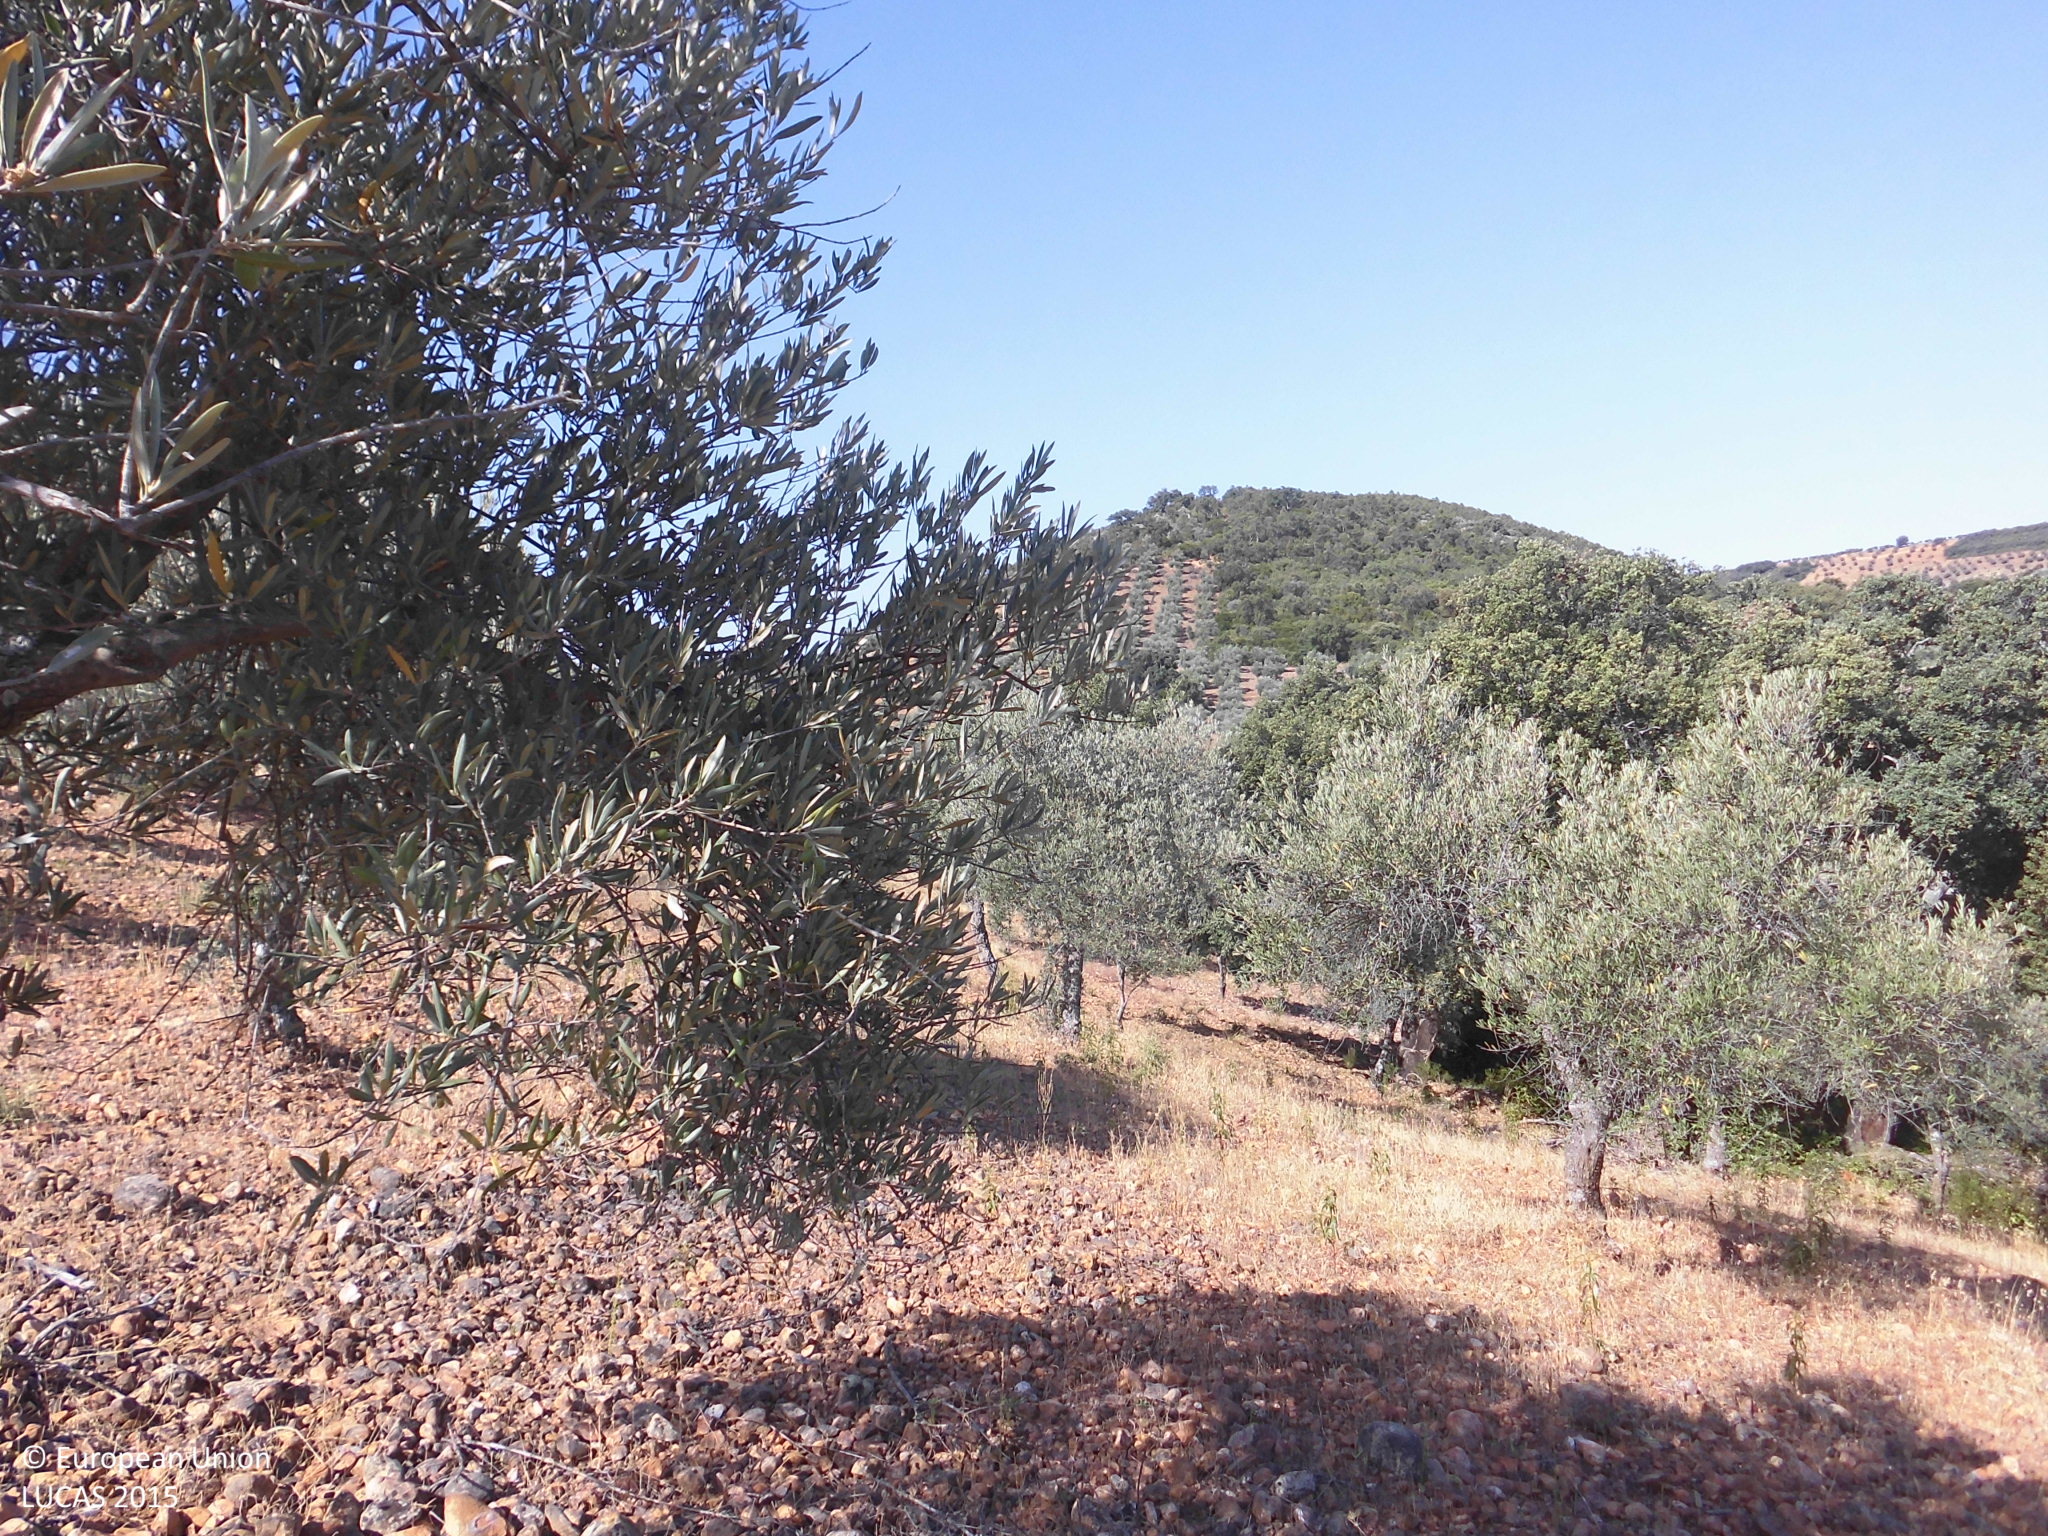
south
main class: Cropland
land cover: Olive groves
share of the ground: 10 - 25 %
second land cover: Other bare soil
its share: > 75 %
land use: Agriculture (excluding fallow land and kitchen gardens)
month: July
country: ES
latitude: 39.6991
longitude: -5.4365
